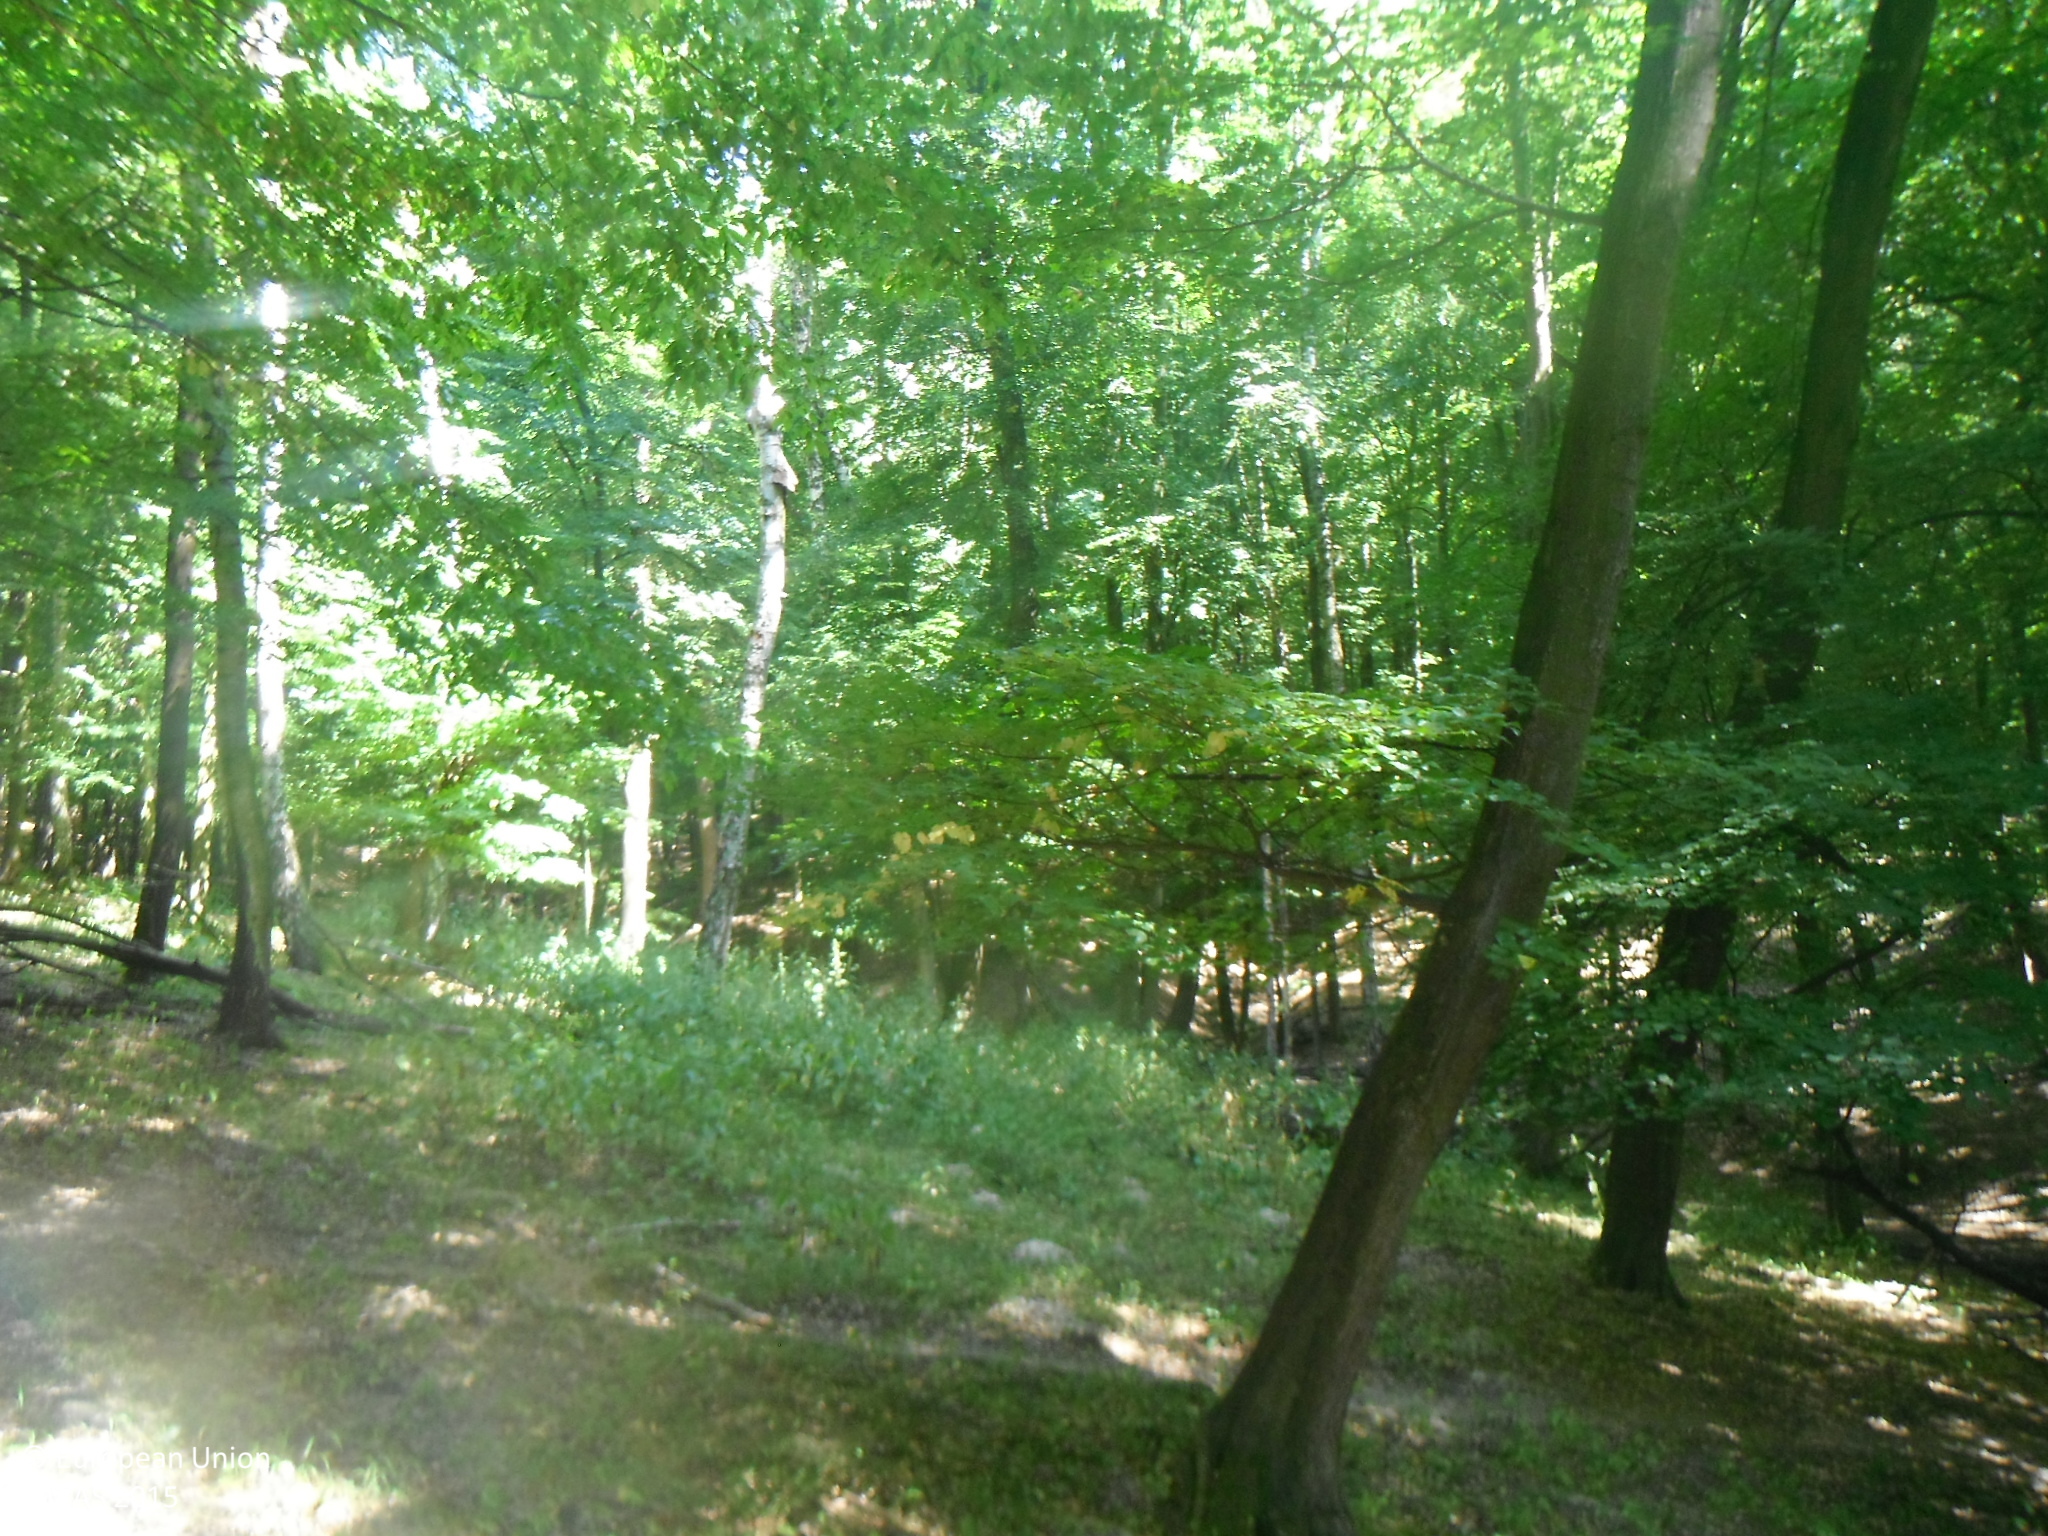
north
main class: Woodland
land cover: Broadleaved woodland
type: mesophytic deciduous forest
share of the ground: > 75 %
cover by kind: broadleaved forest trees 95 %, herbaceous plants 5 %
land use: Forestry
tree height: > 5 m
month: July
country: SK
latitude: 48.7250
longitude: 17.2554
